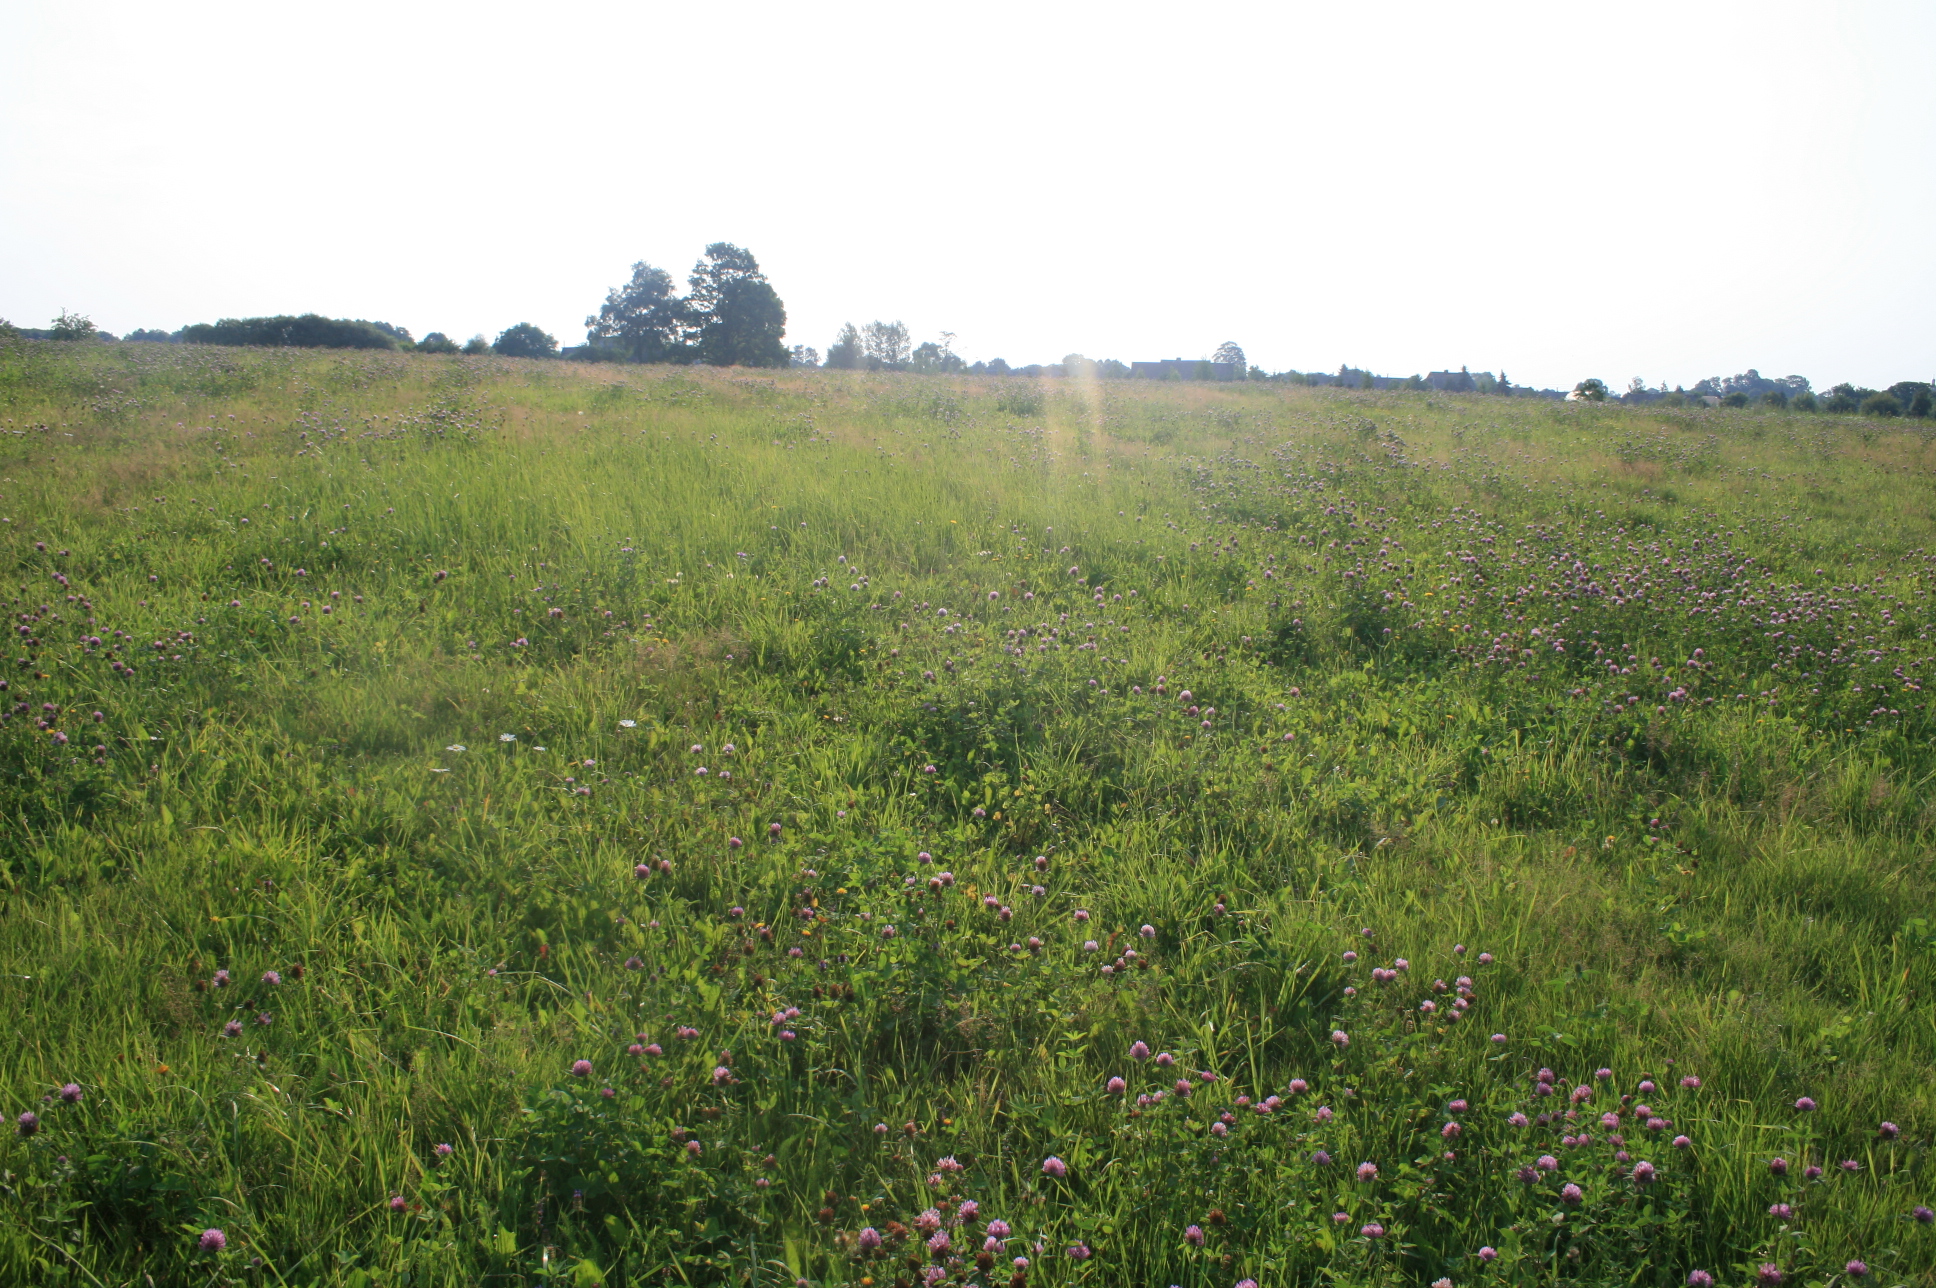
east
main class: Cropland
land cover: Other leguminous and mixtures for fodder
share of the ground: > 75 %
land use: Agriculture (excluding fallow land and kitchen gardens)
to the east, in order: Other leguminous and mixtures for fodder; Grassland without tree/shrub cover; Artificial constructions in urban areas
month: August
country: LT
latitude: 55.6063
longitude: 21.5867
